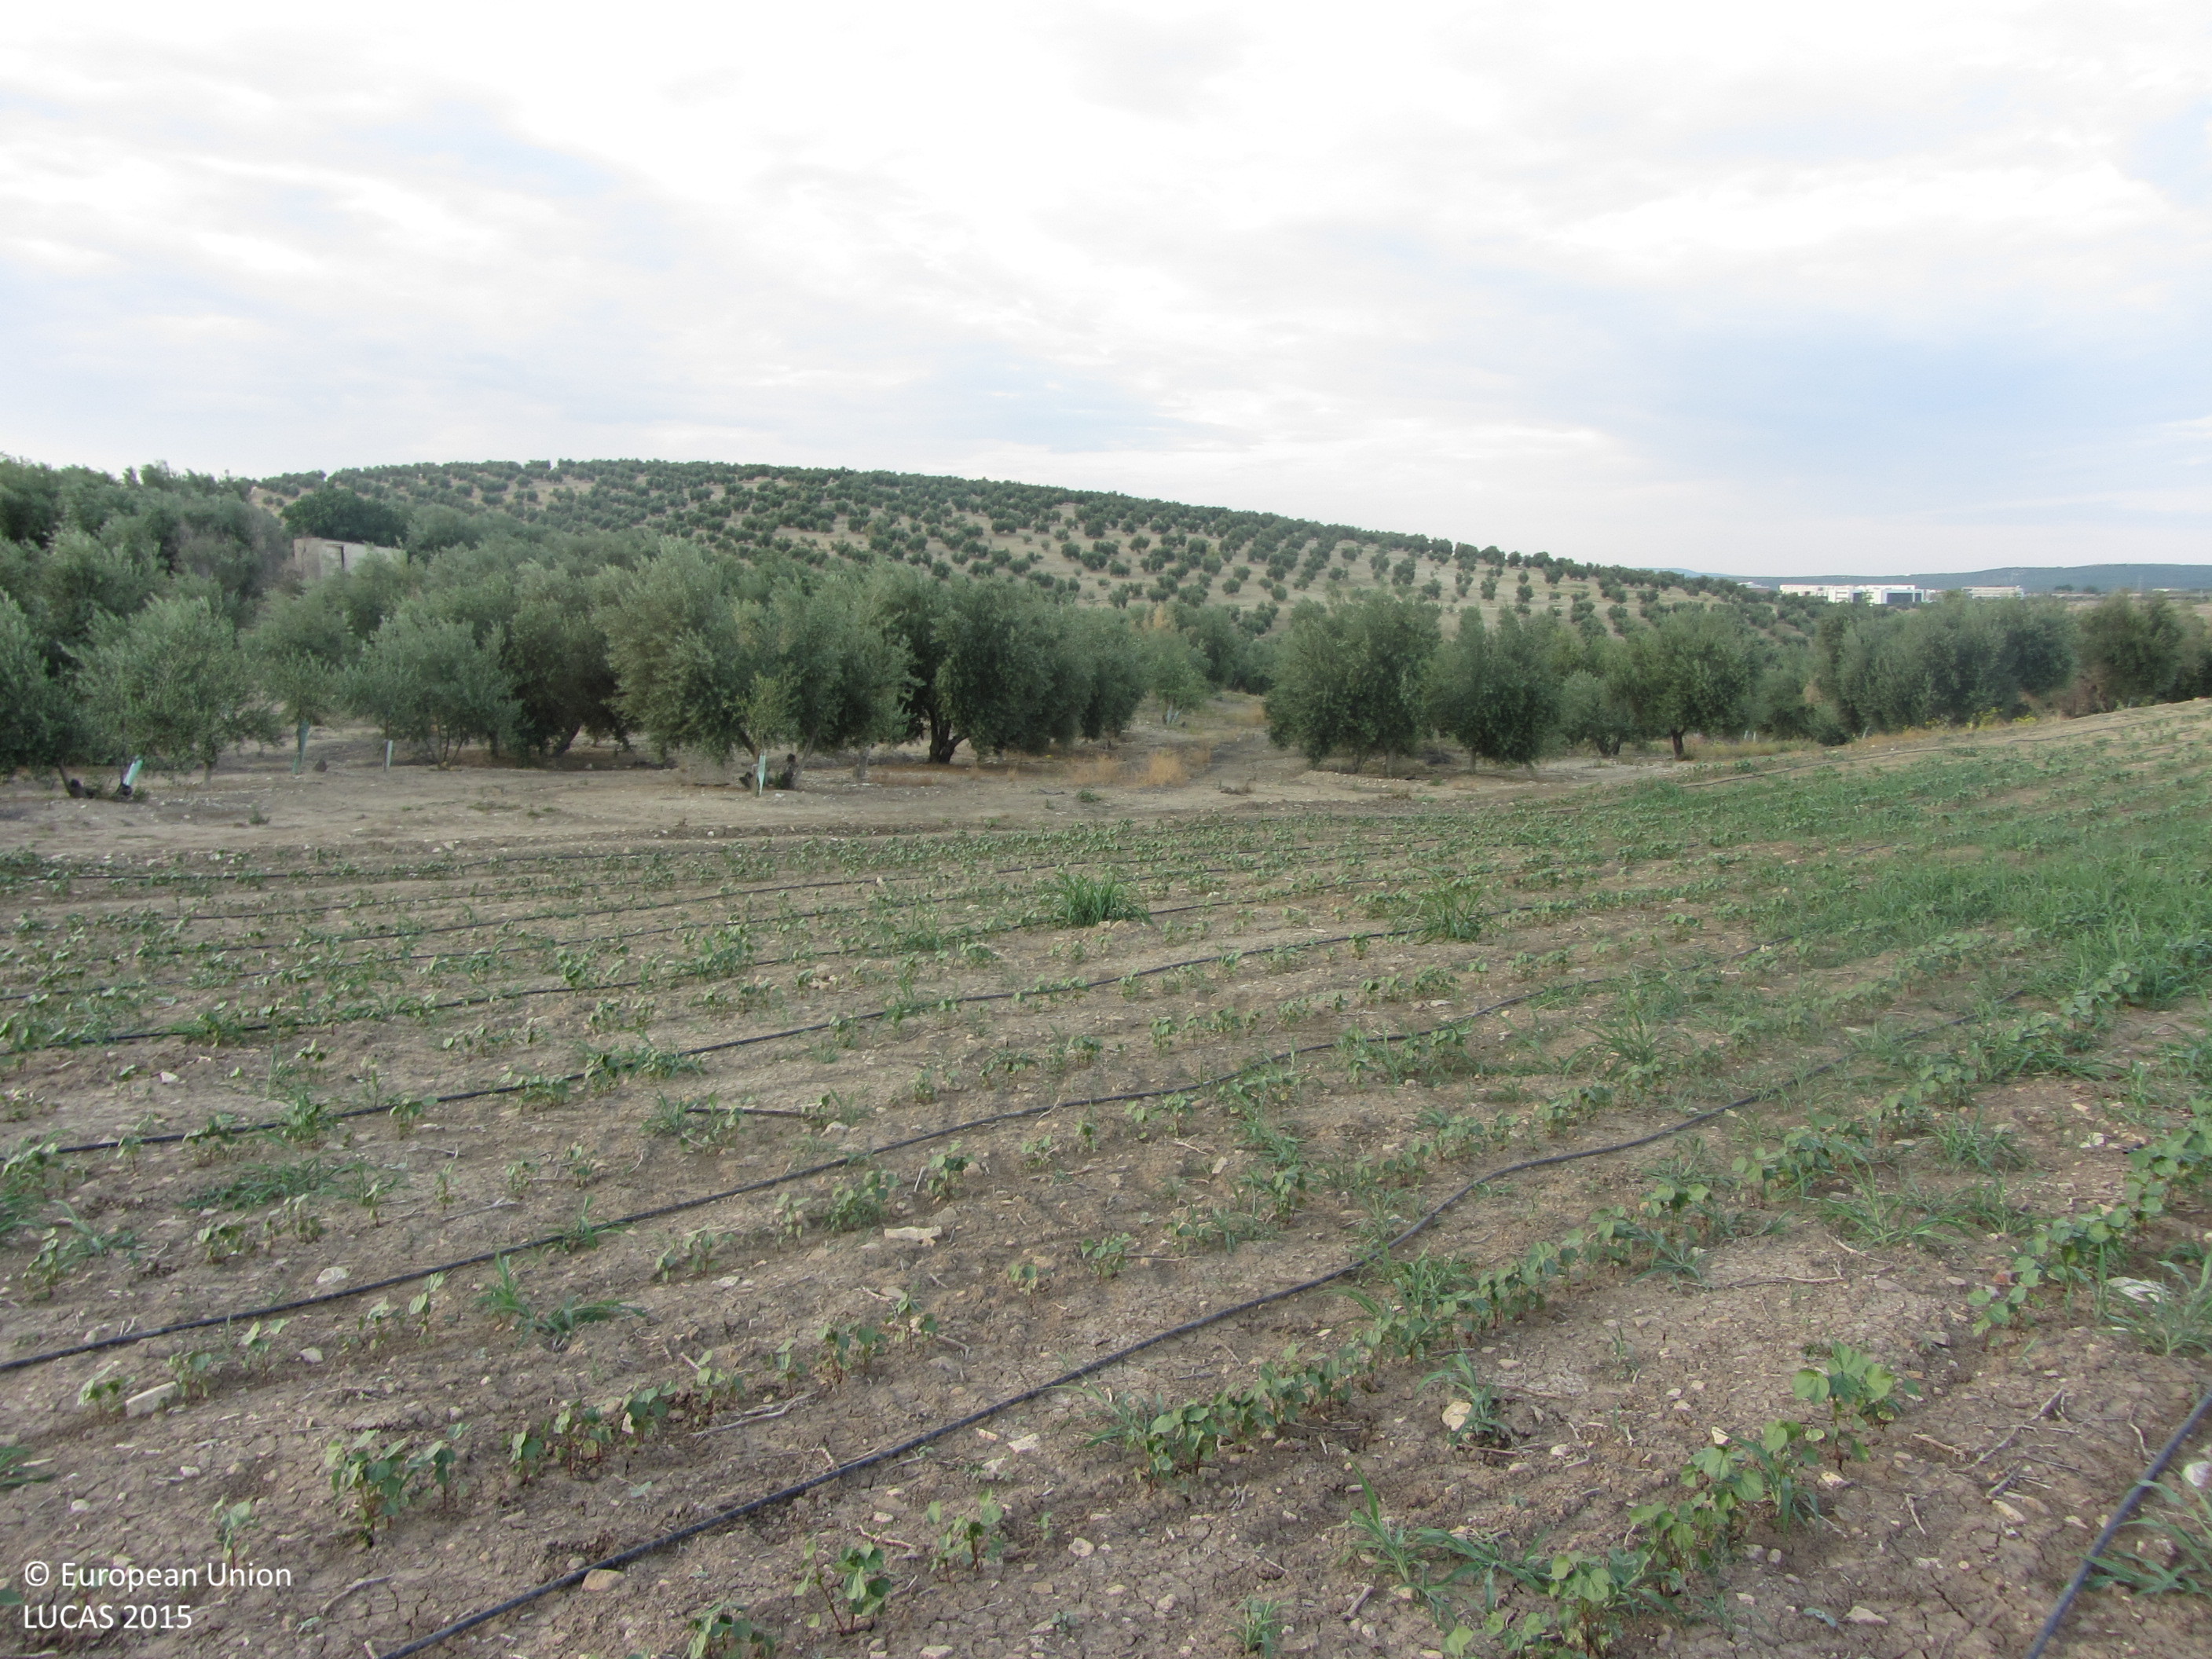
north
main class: Cropland
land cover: Cotton
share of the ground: < 10 %
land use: Agriculture (excluding fallow land and kitchen gardens)
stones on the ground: < 10 %
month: June
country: ES
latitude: 37.9292
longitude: -3.8036
